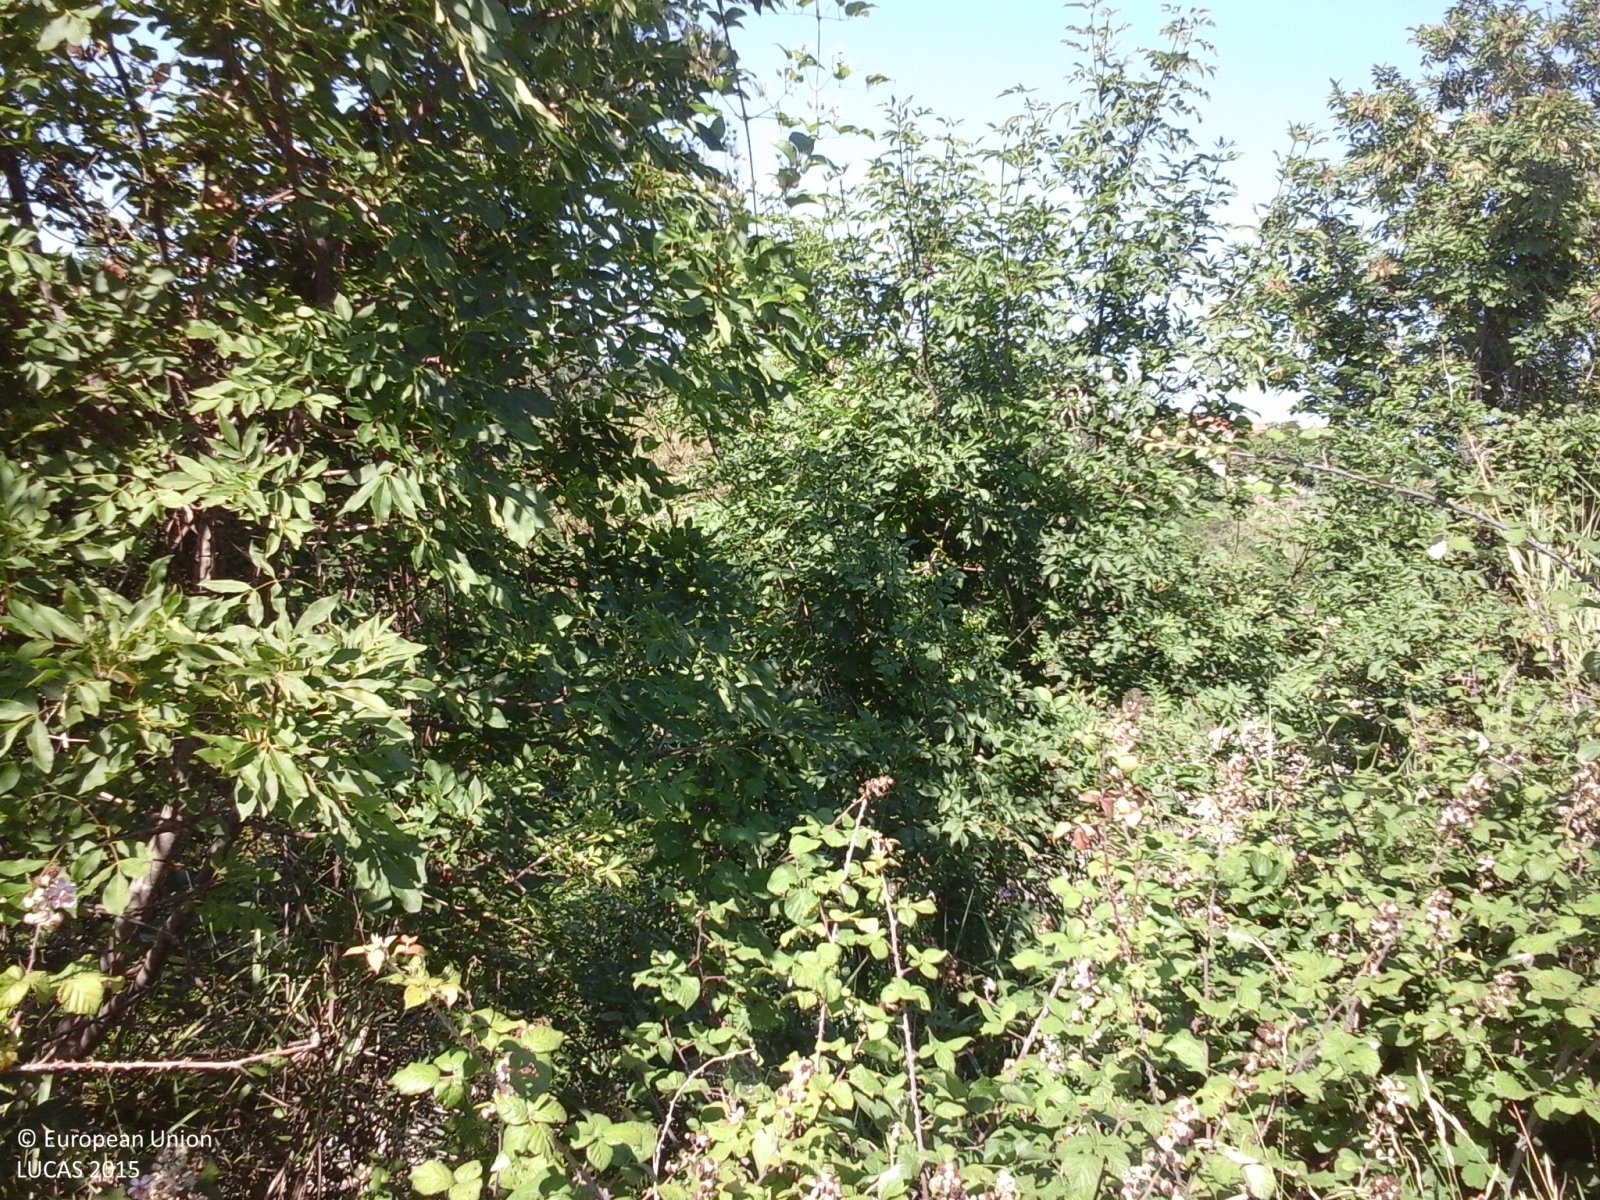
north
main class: Shrubland
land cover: Shrubland with sparse tree cover
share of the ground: > 75 %
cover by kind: shrubs 90 %, broadleaved forest trees 5 %, herbaceous plants 5 %
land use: Semi-natural and natural areas not in use
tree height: < 5 m
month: July
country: IT
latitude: 42.3608
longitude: 14.3702
